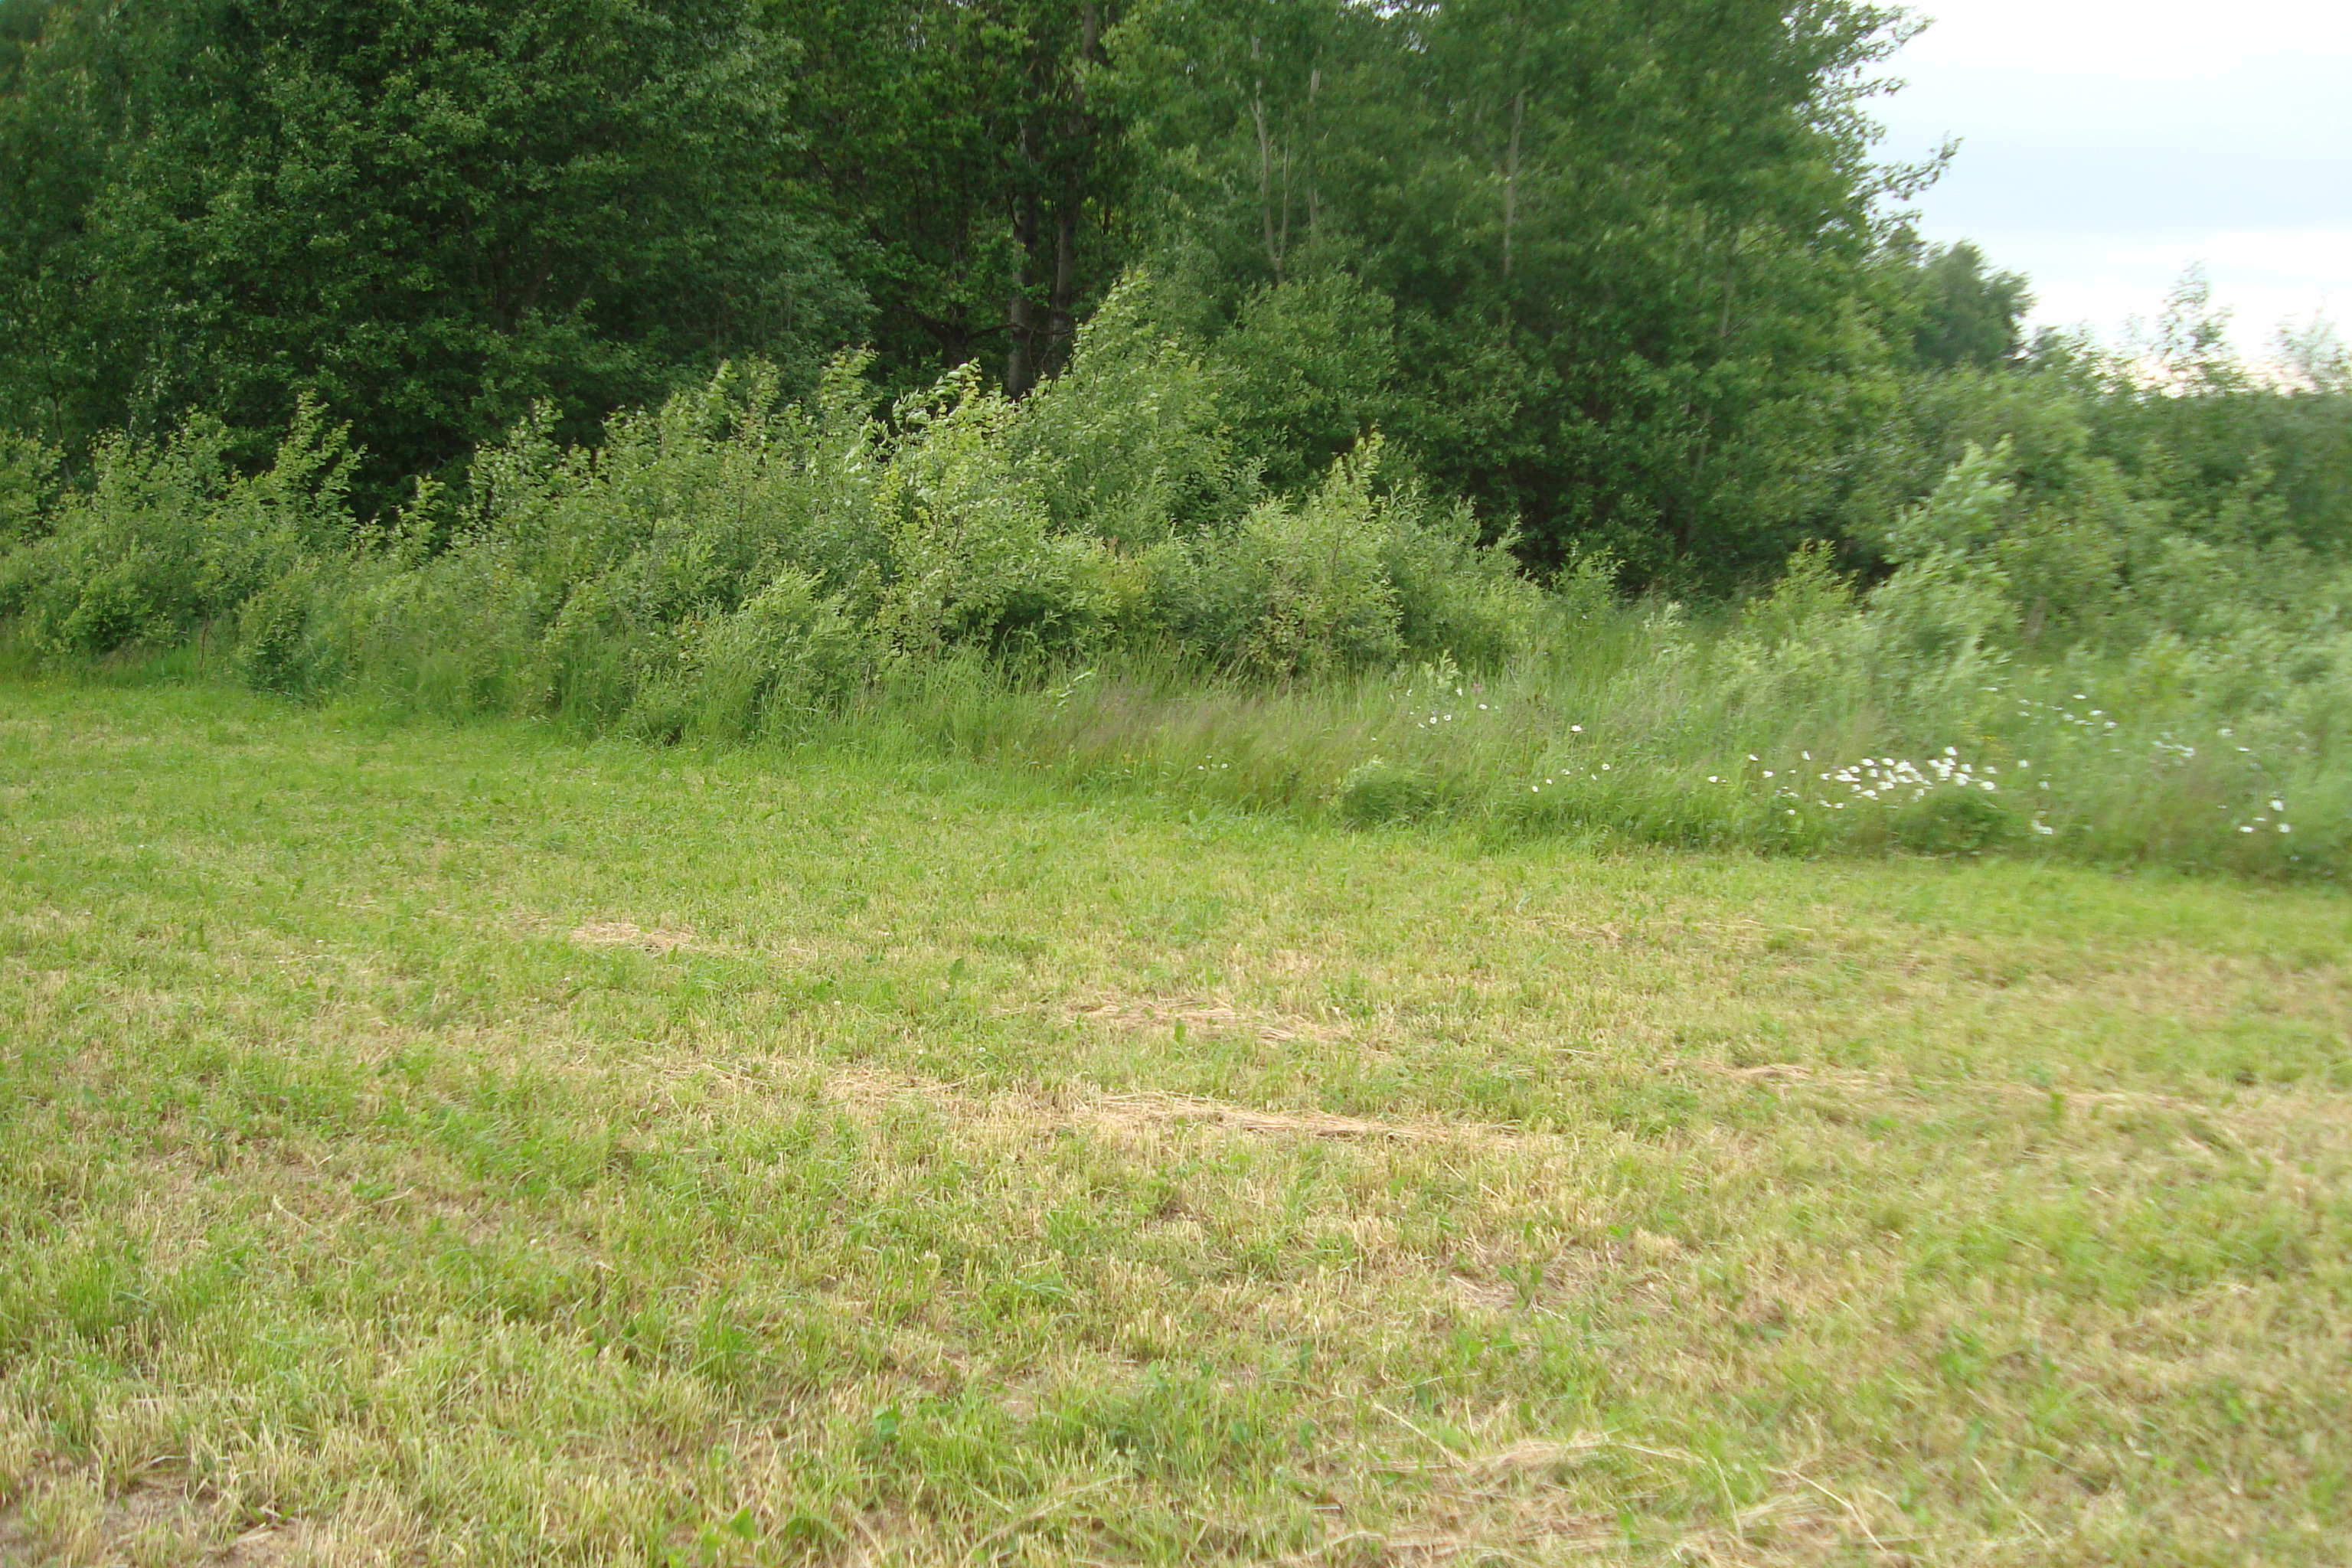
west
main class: Cropland
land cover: Lucerne
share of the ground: > 75 %
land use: Agriculture (excluding fallow land and kitchen gardens)
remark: Harvested field
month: June
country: LV
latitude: 57.2038
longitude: 26.3796
